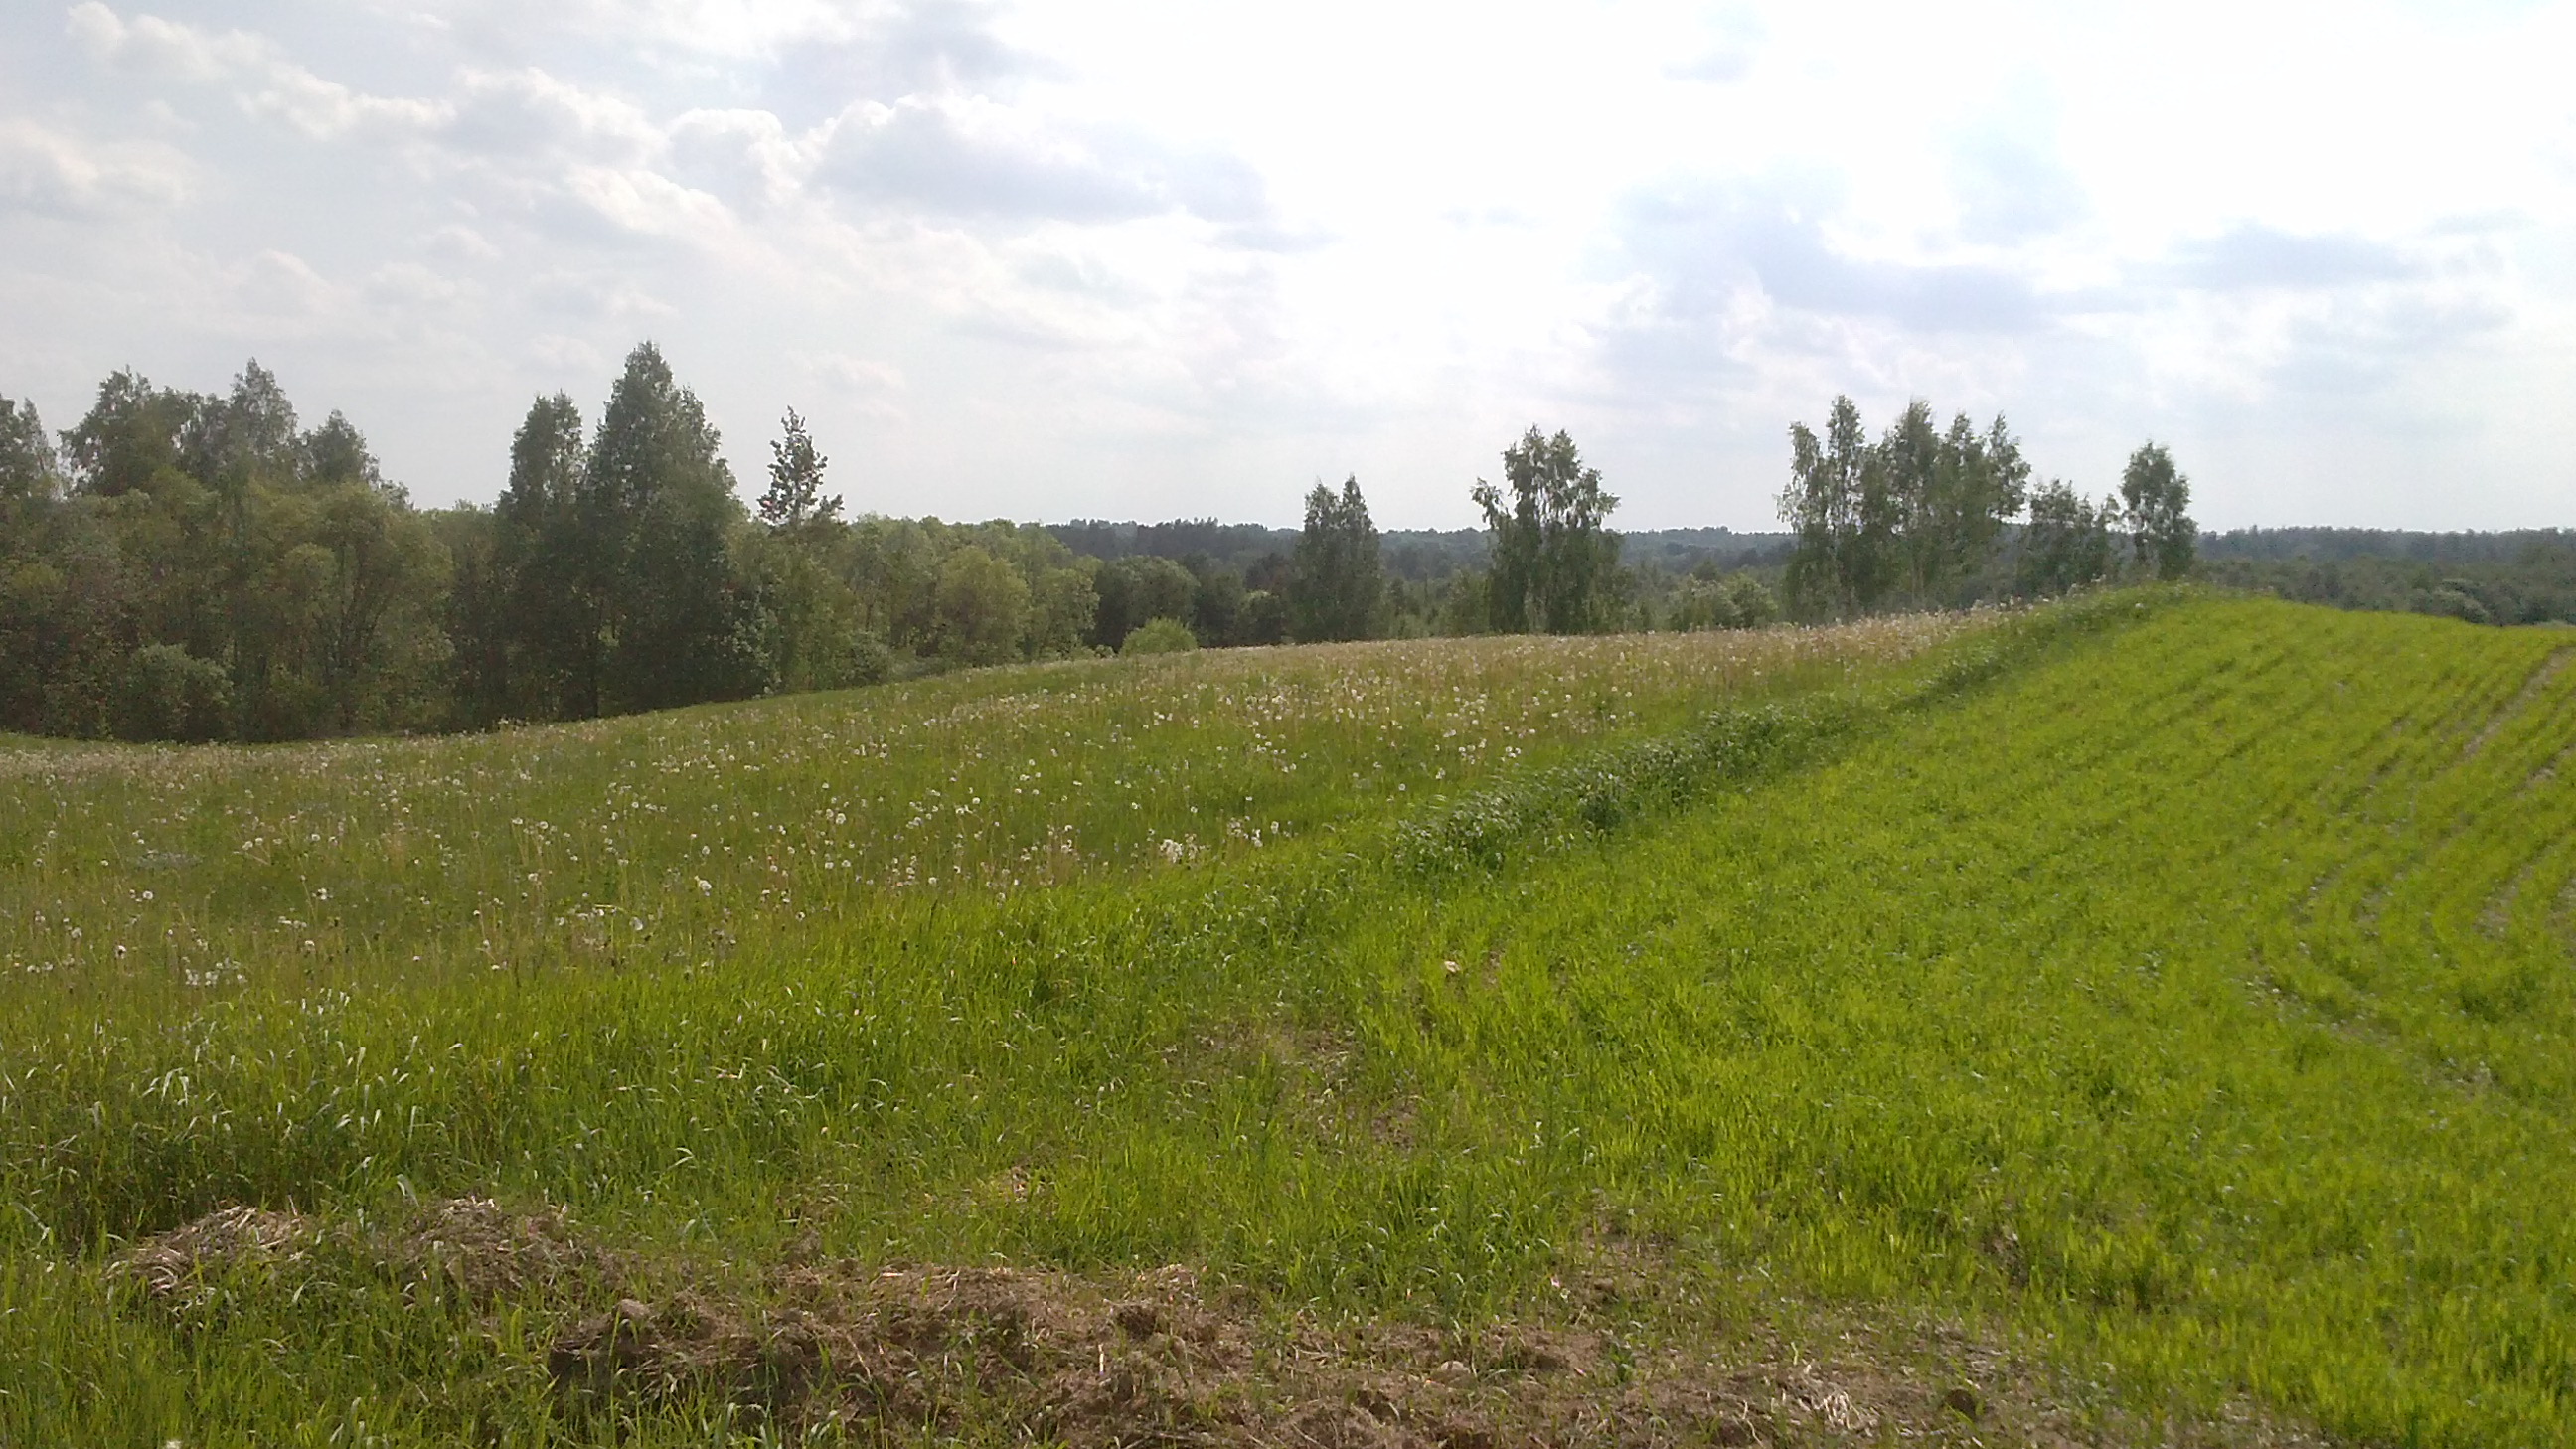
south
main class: Cropland
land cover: Oats
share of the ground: > 75 %
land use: Agriculture (excluding fallow land and kitchen gardens)
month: June
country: LV
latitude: 56.2127
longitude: 28.1151
